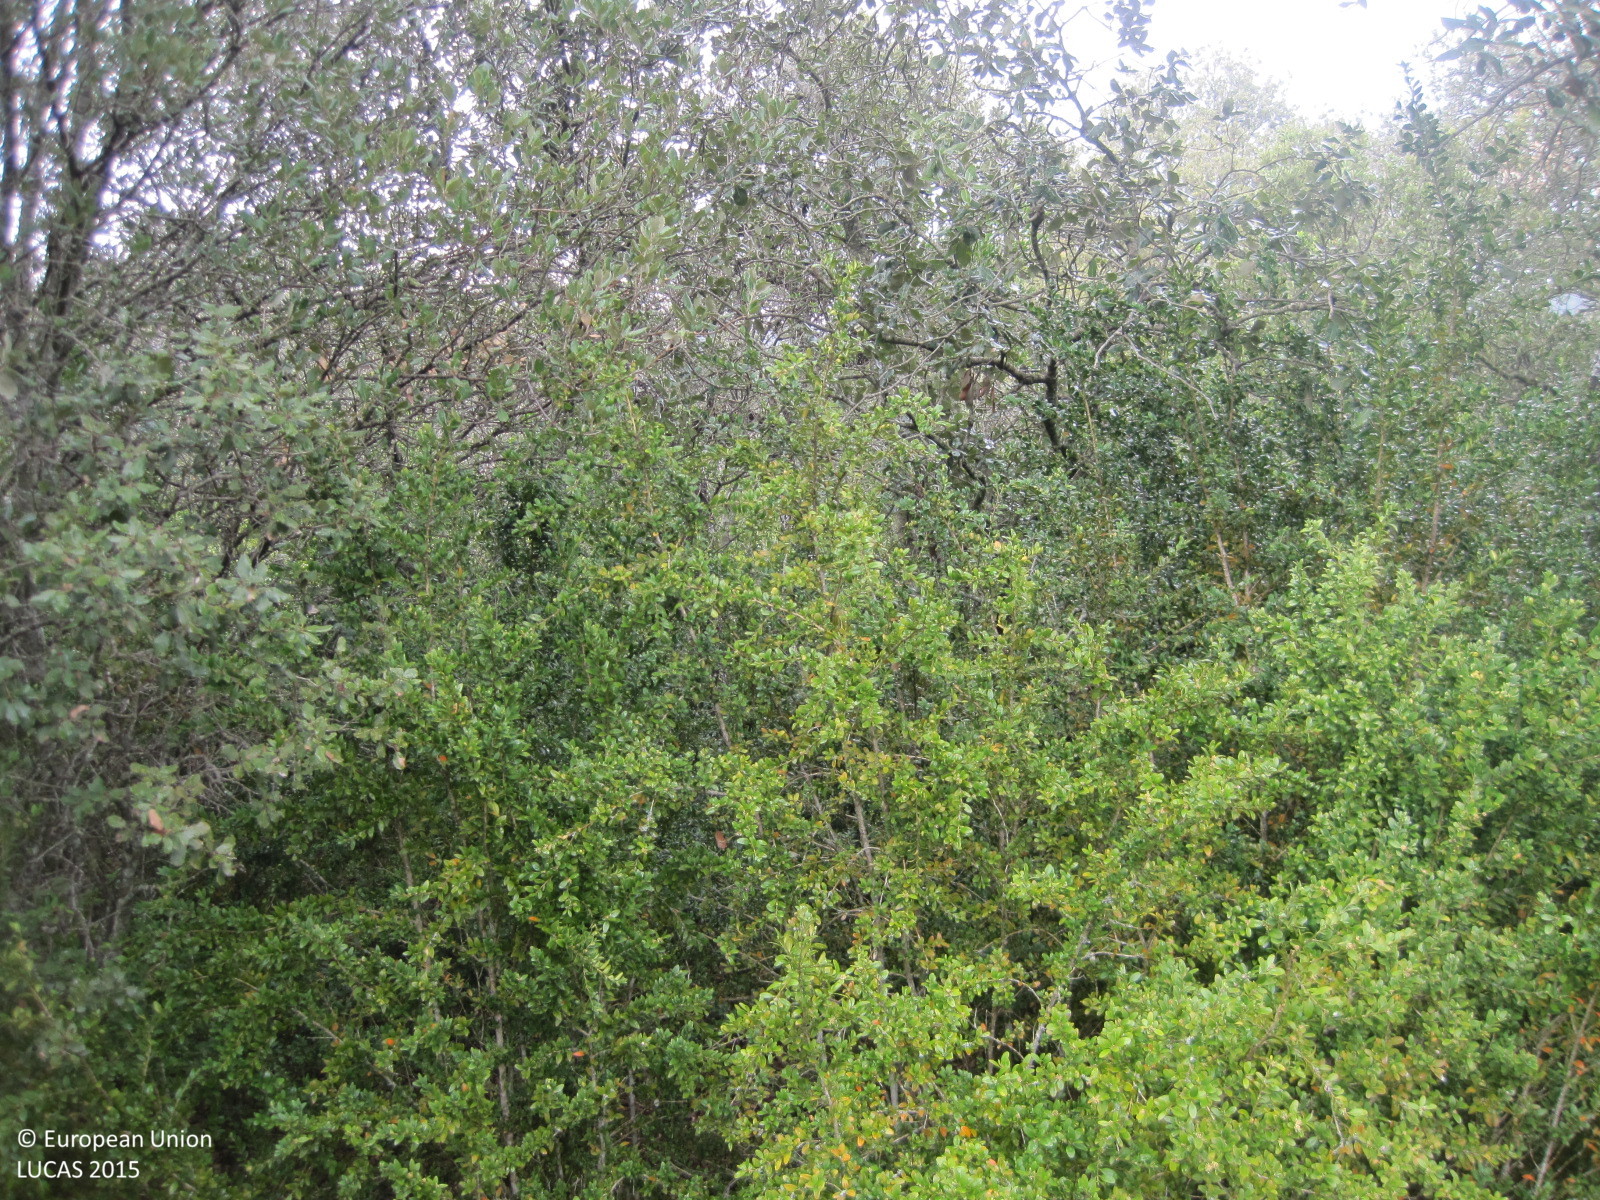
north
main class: Woodland
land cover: Broadleaved woodland
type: broadleaved evergreen forest
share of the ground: > 75 %
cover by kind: broadleaved forest trees 100 %
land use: Semi-natural and natural areas not in use
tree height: > 5 m
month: April
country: ES
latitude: 42.6842
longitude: -2.1625
